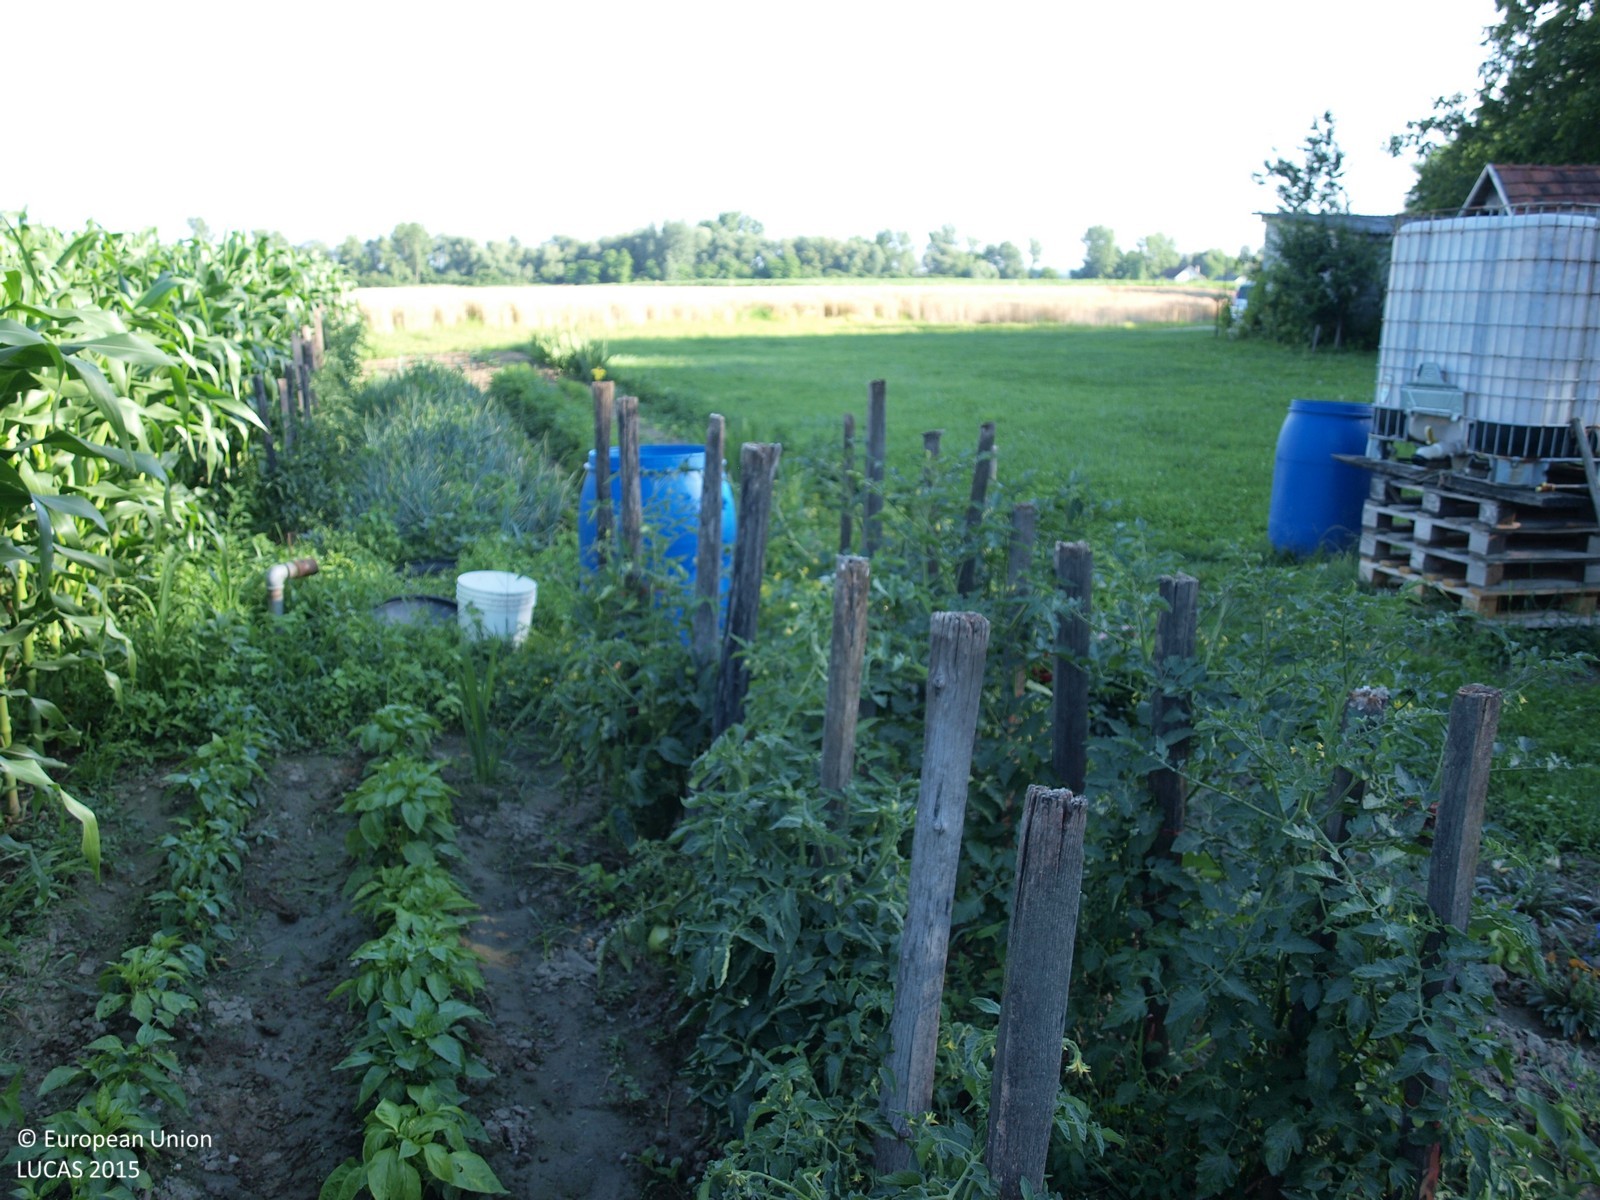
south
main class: Cropland
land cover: Other fresh vegetables
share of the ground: 50 - 75 %
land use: Agriculture (excluding fallow land and kitchen gardens)
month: June
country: HR
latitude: 46.2849
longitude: 16.7114
